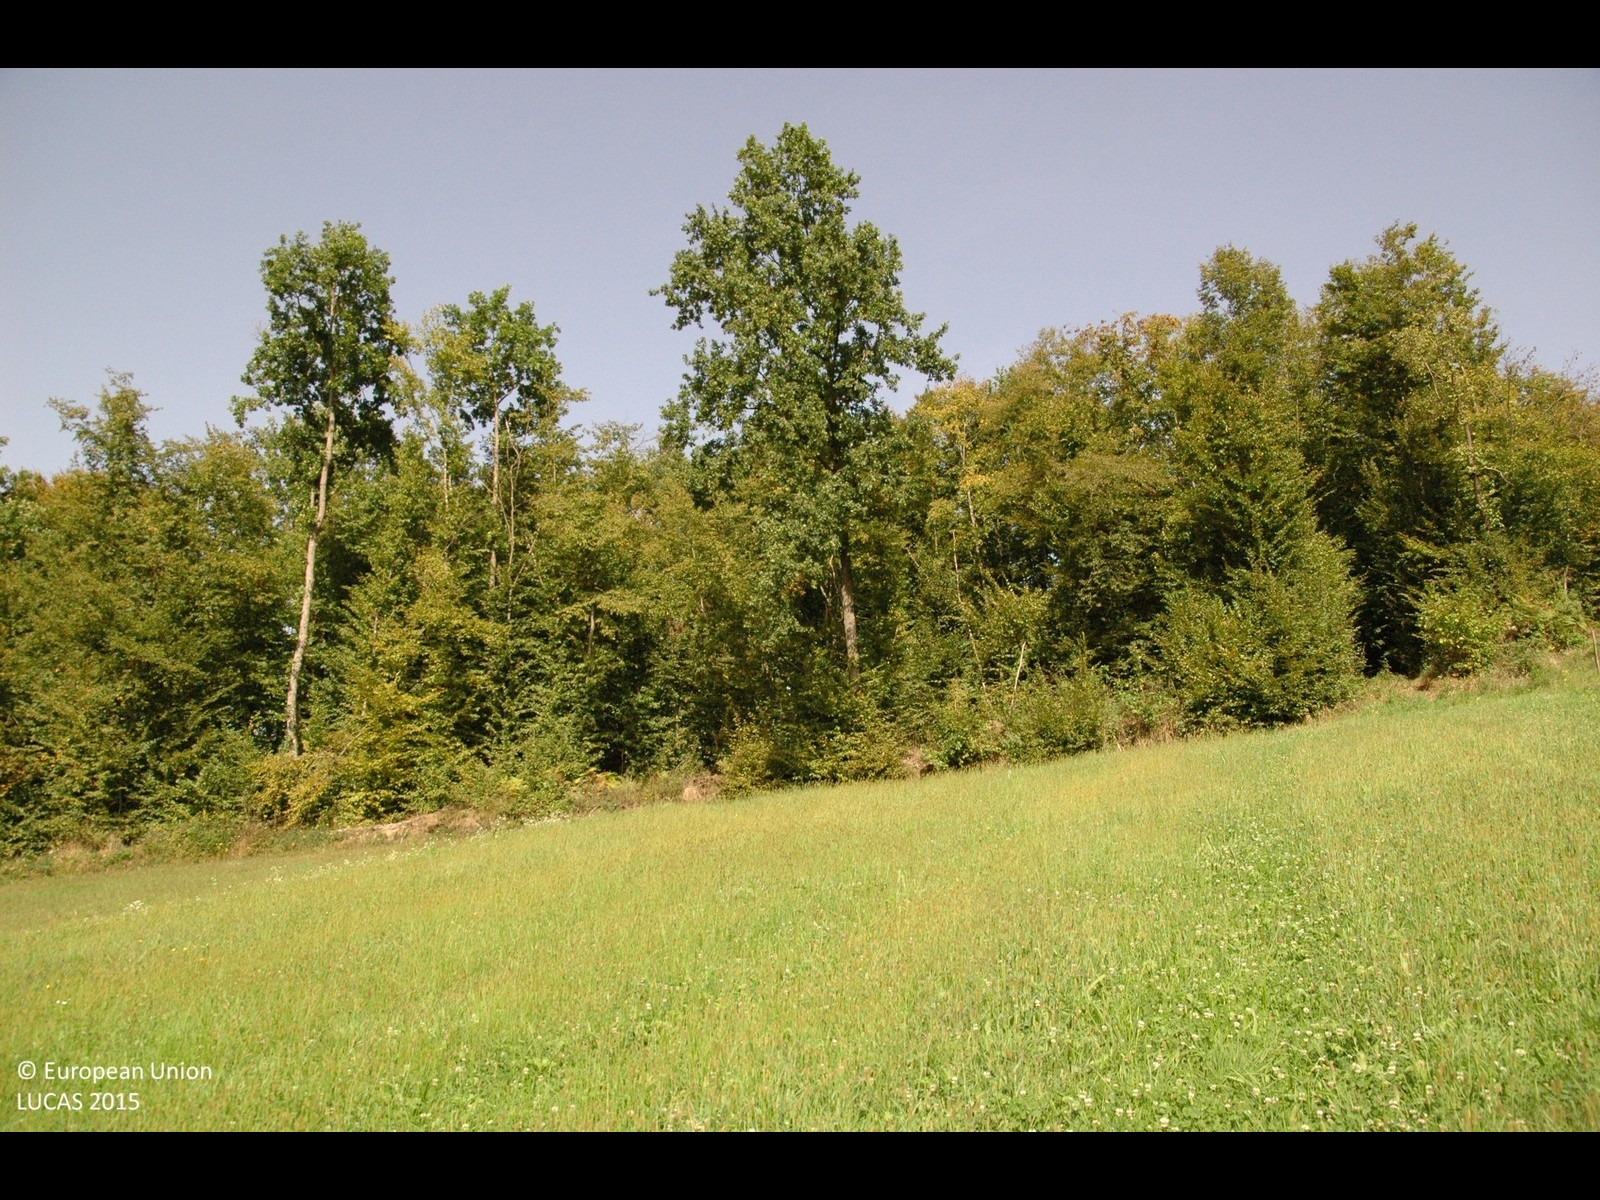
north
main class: Grassland
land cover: Grassland without tree/shrub cover
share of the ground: > 75 %
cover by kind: herbaceous plants 100 %
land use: Agriculture (excluding fallow land and kitchen gardens)
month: September
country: HR
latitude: 45.5352
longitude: 15.9517
